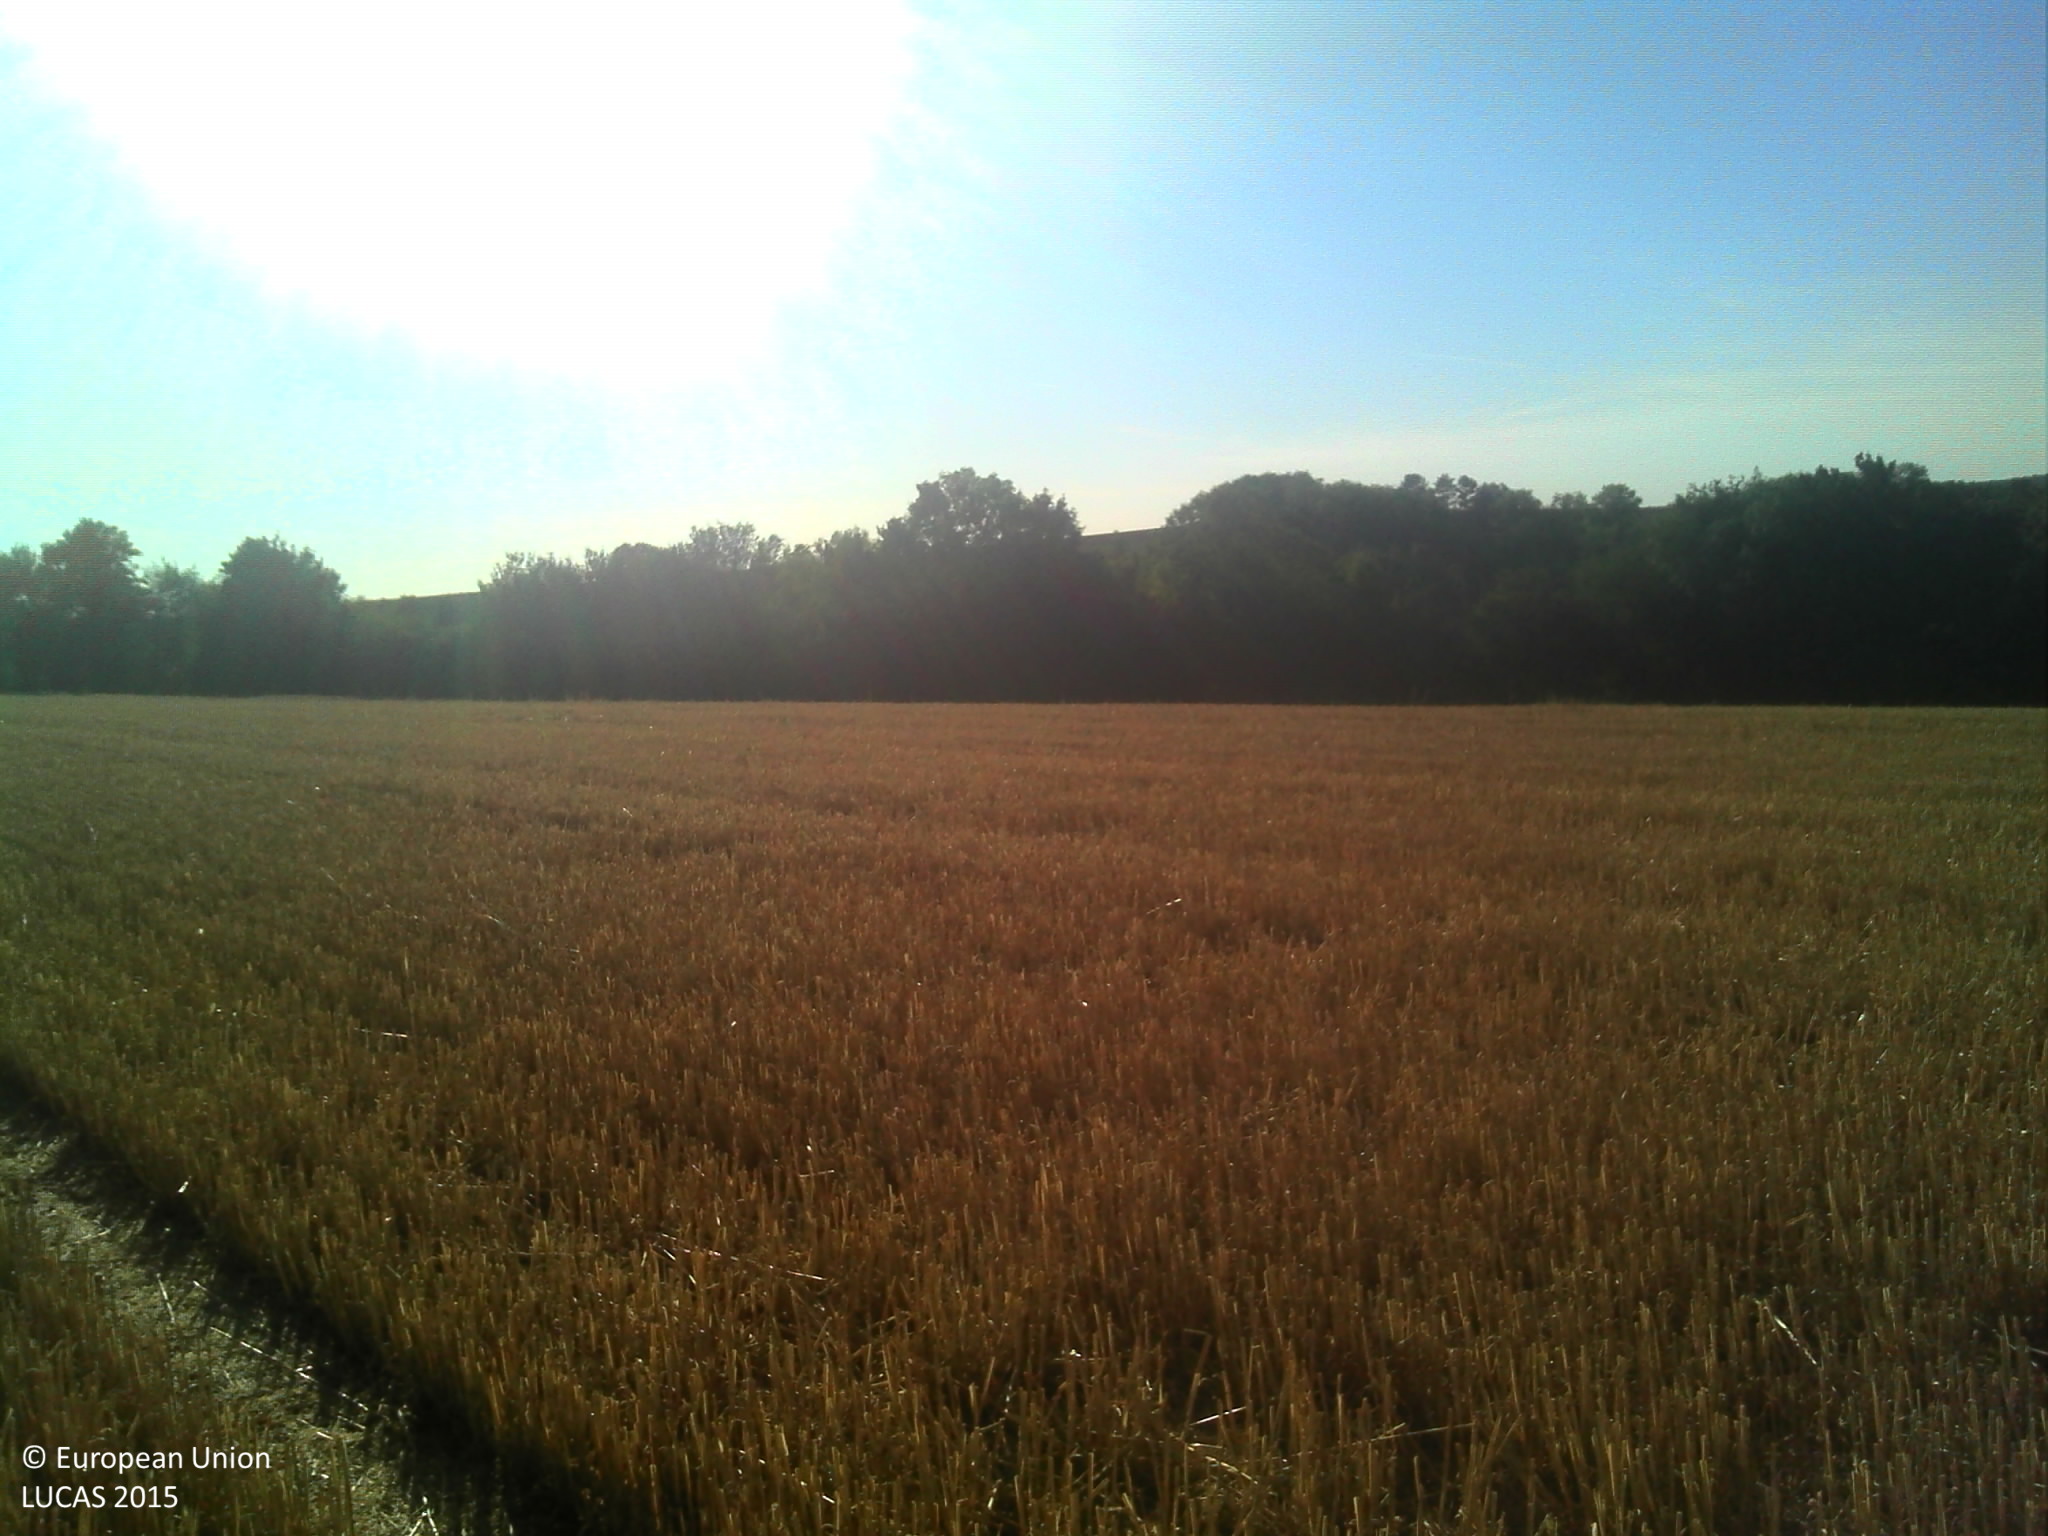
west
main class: Cropland
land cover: Common wheat
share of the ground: 10 - 25 %
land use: Agriculture (excluding fallow land and kitchen gardens)
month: August
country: FR
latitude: 47.7841
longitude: 4.9676
